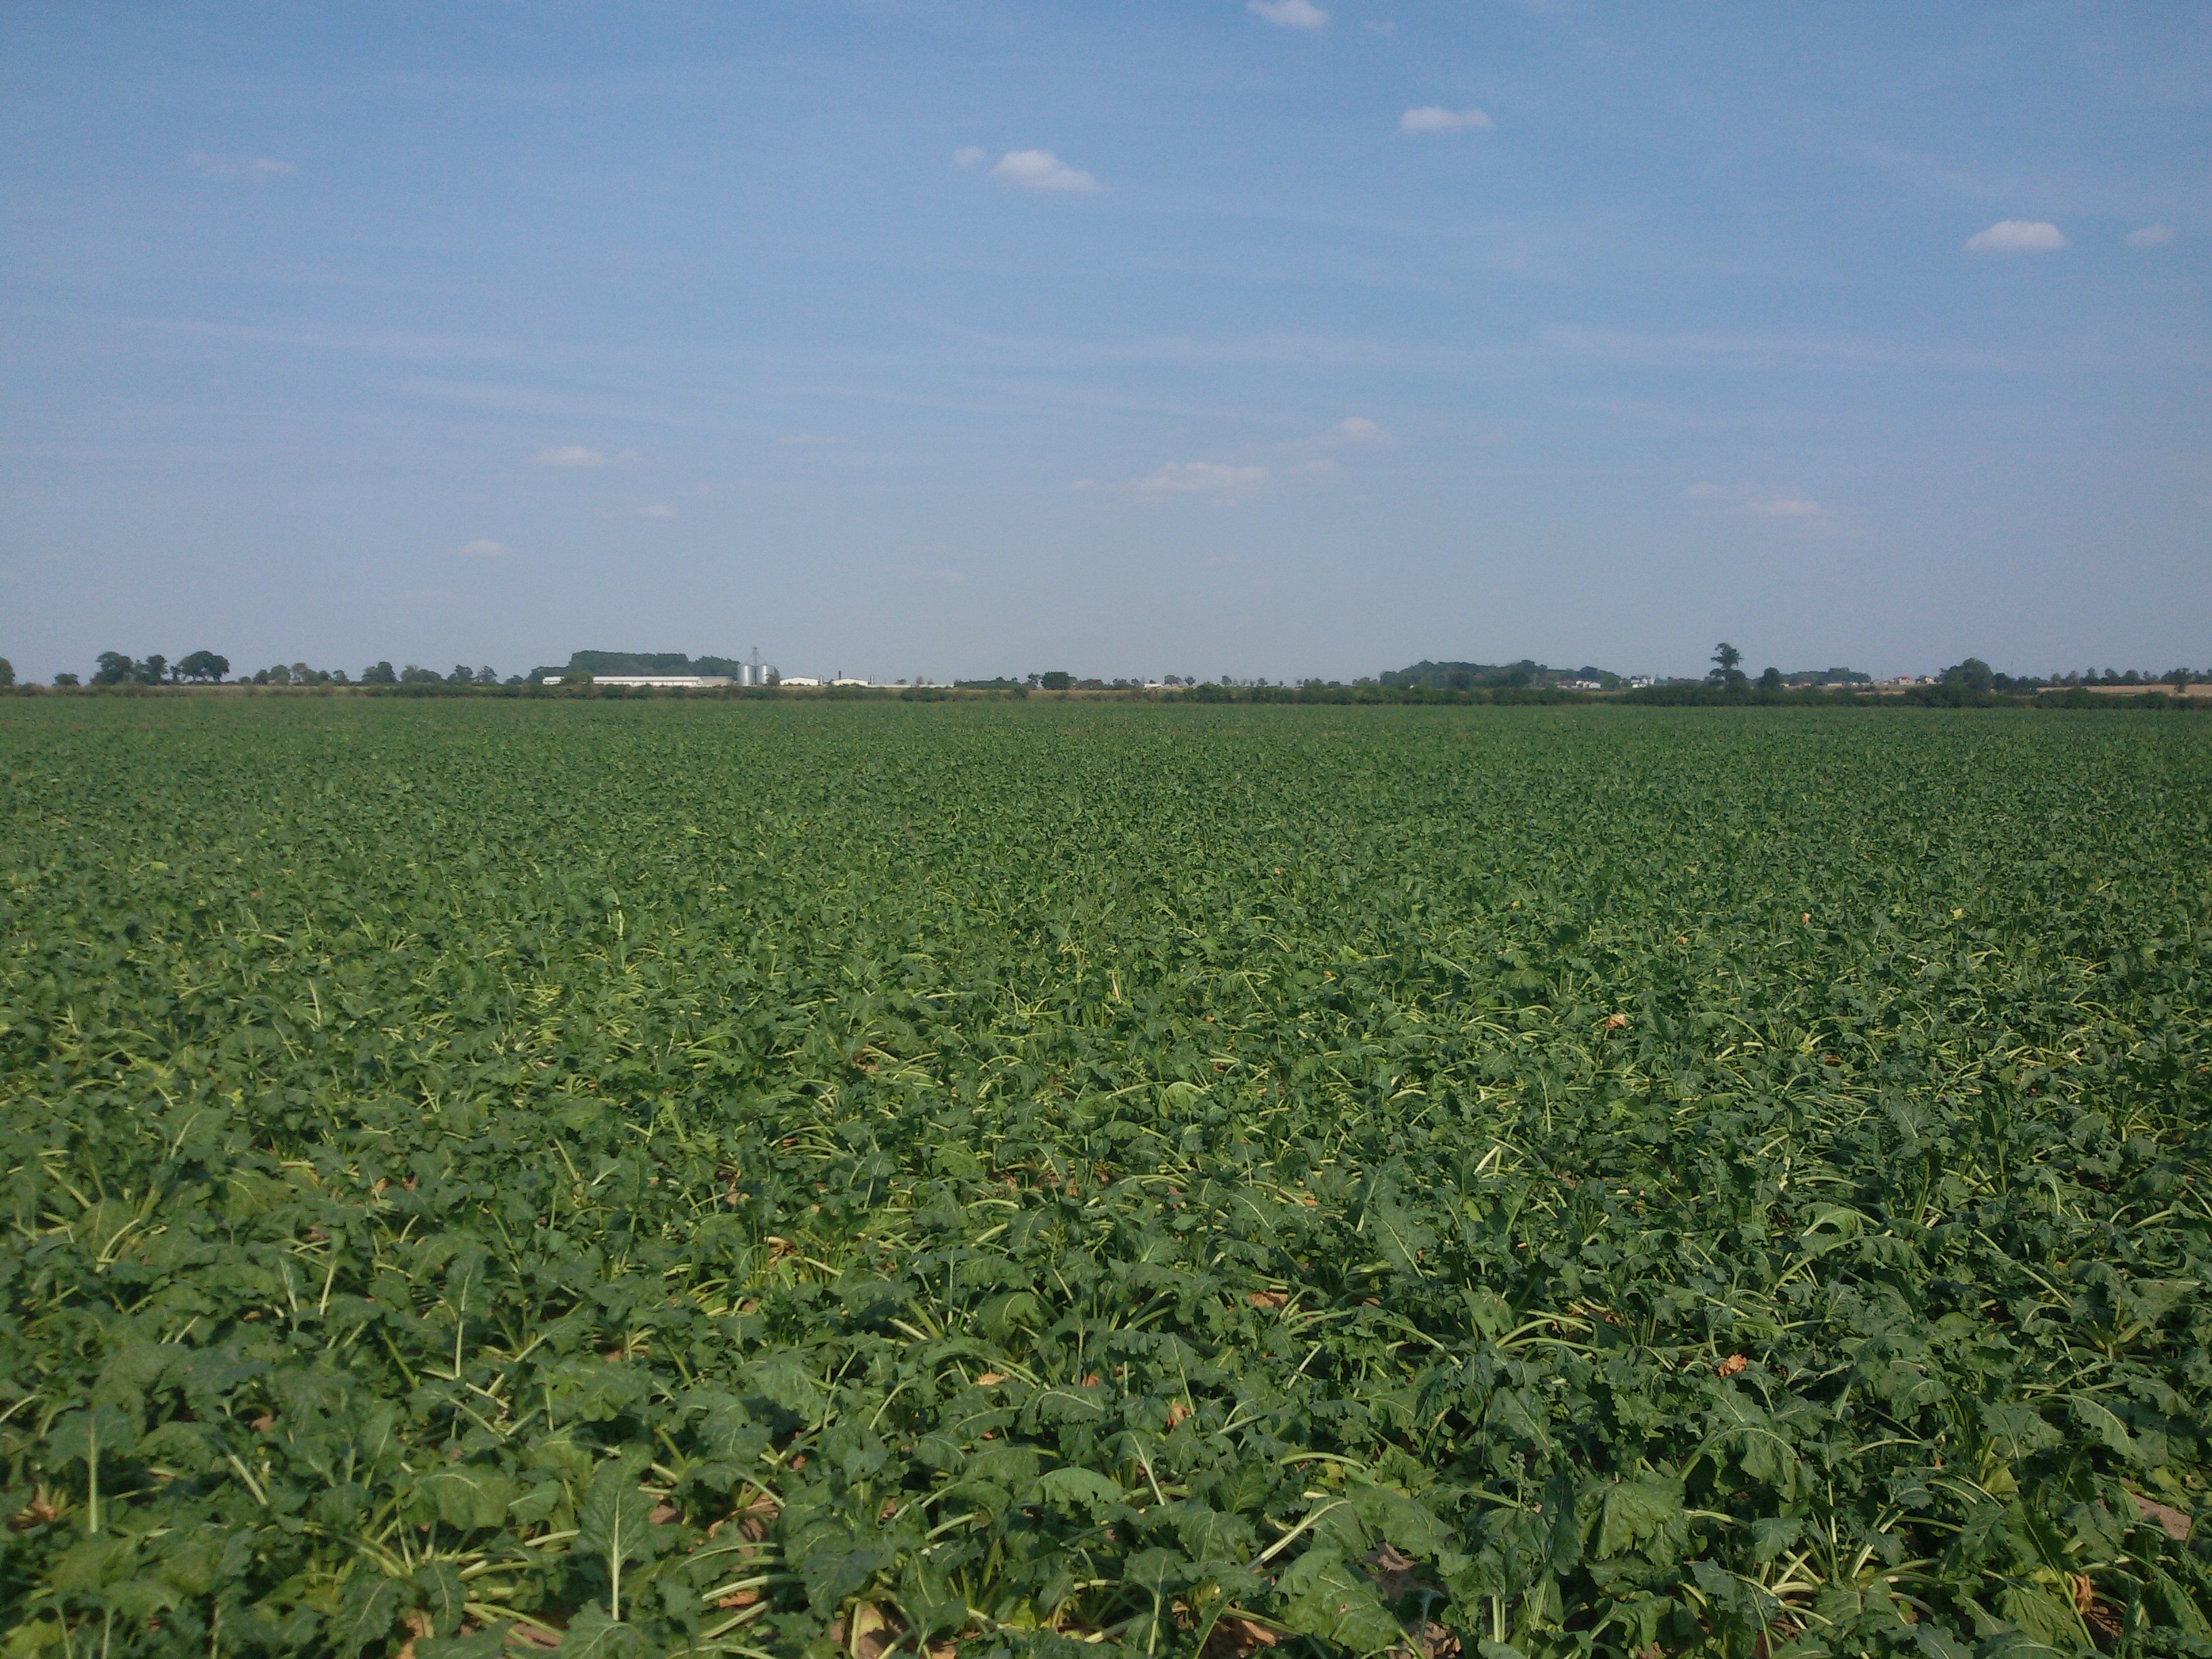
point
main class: Cropland
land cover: Sugar beet
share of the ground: > 75 %
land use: Agriculture (excluding fallow land and kitchen gardens)
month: August
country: PL
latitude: 51.8020
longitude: 17.4227
